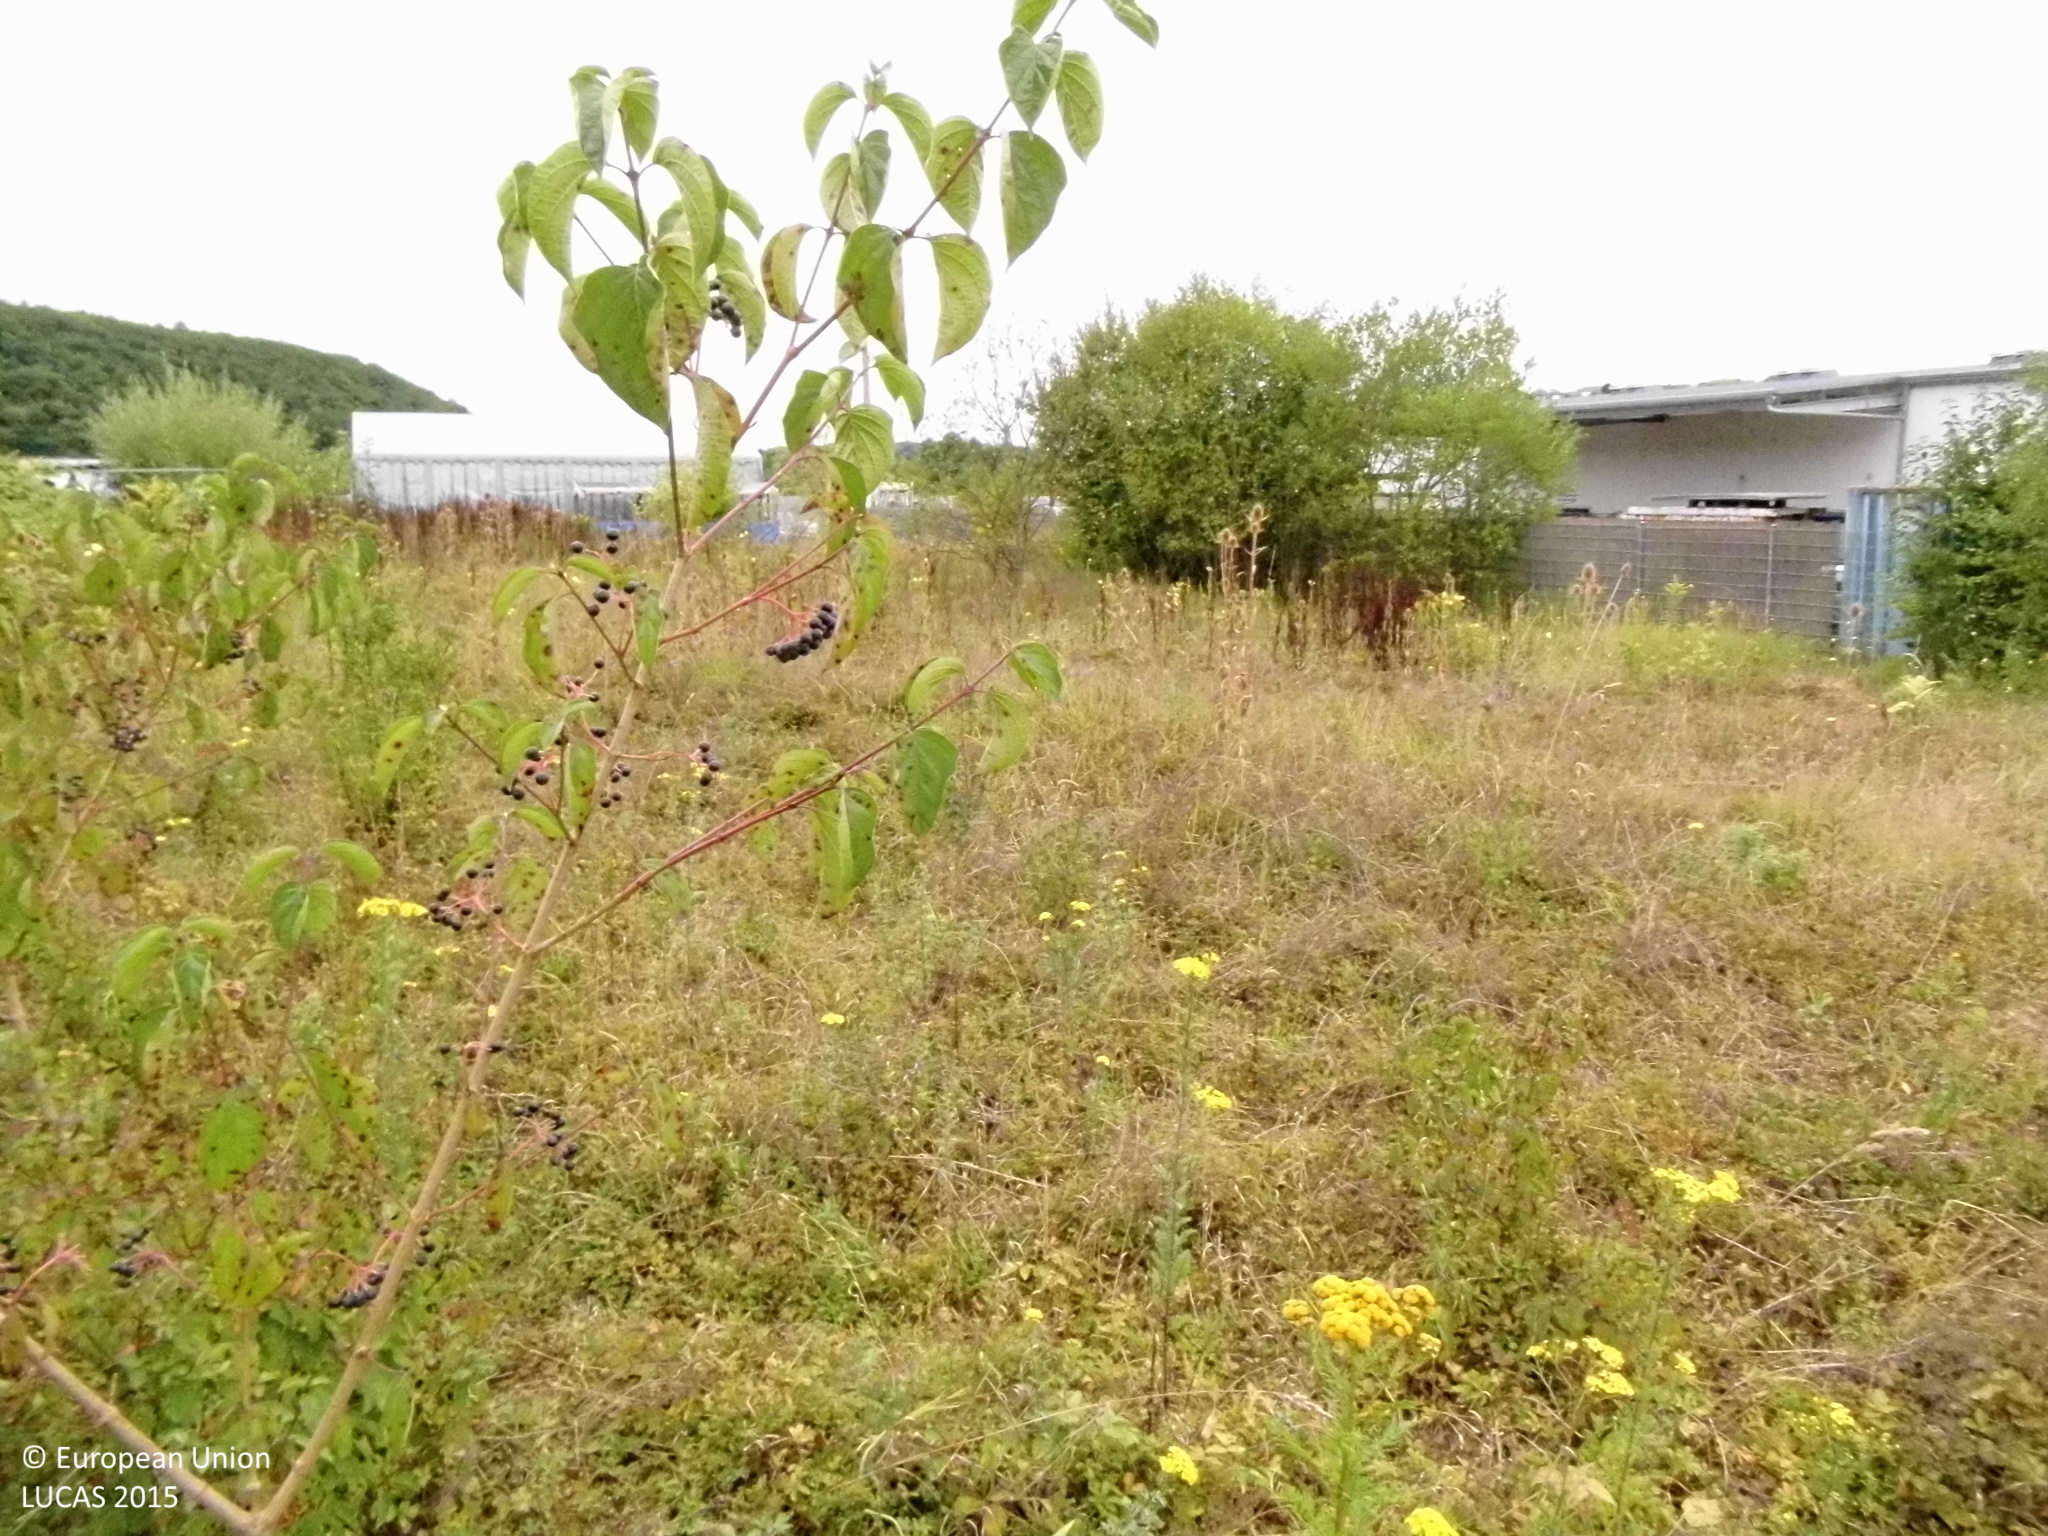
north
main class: Shrubland
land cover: Shrubland without tree cover
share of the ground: > 75 %
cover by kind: shrubs 90 %, herbaceous plants 10 %
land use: Semi-natural and natural areas not in use
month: August
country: DE
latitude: 50.4027
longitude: 8.1292
